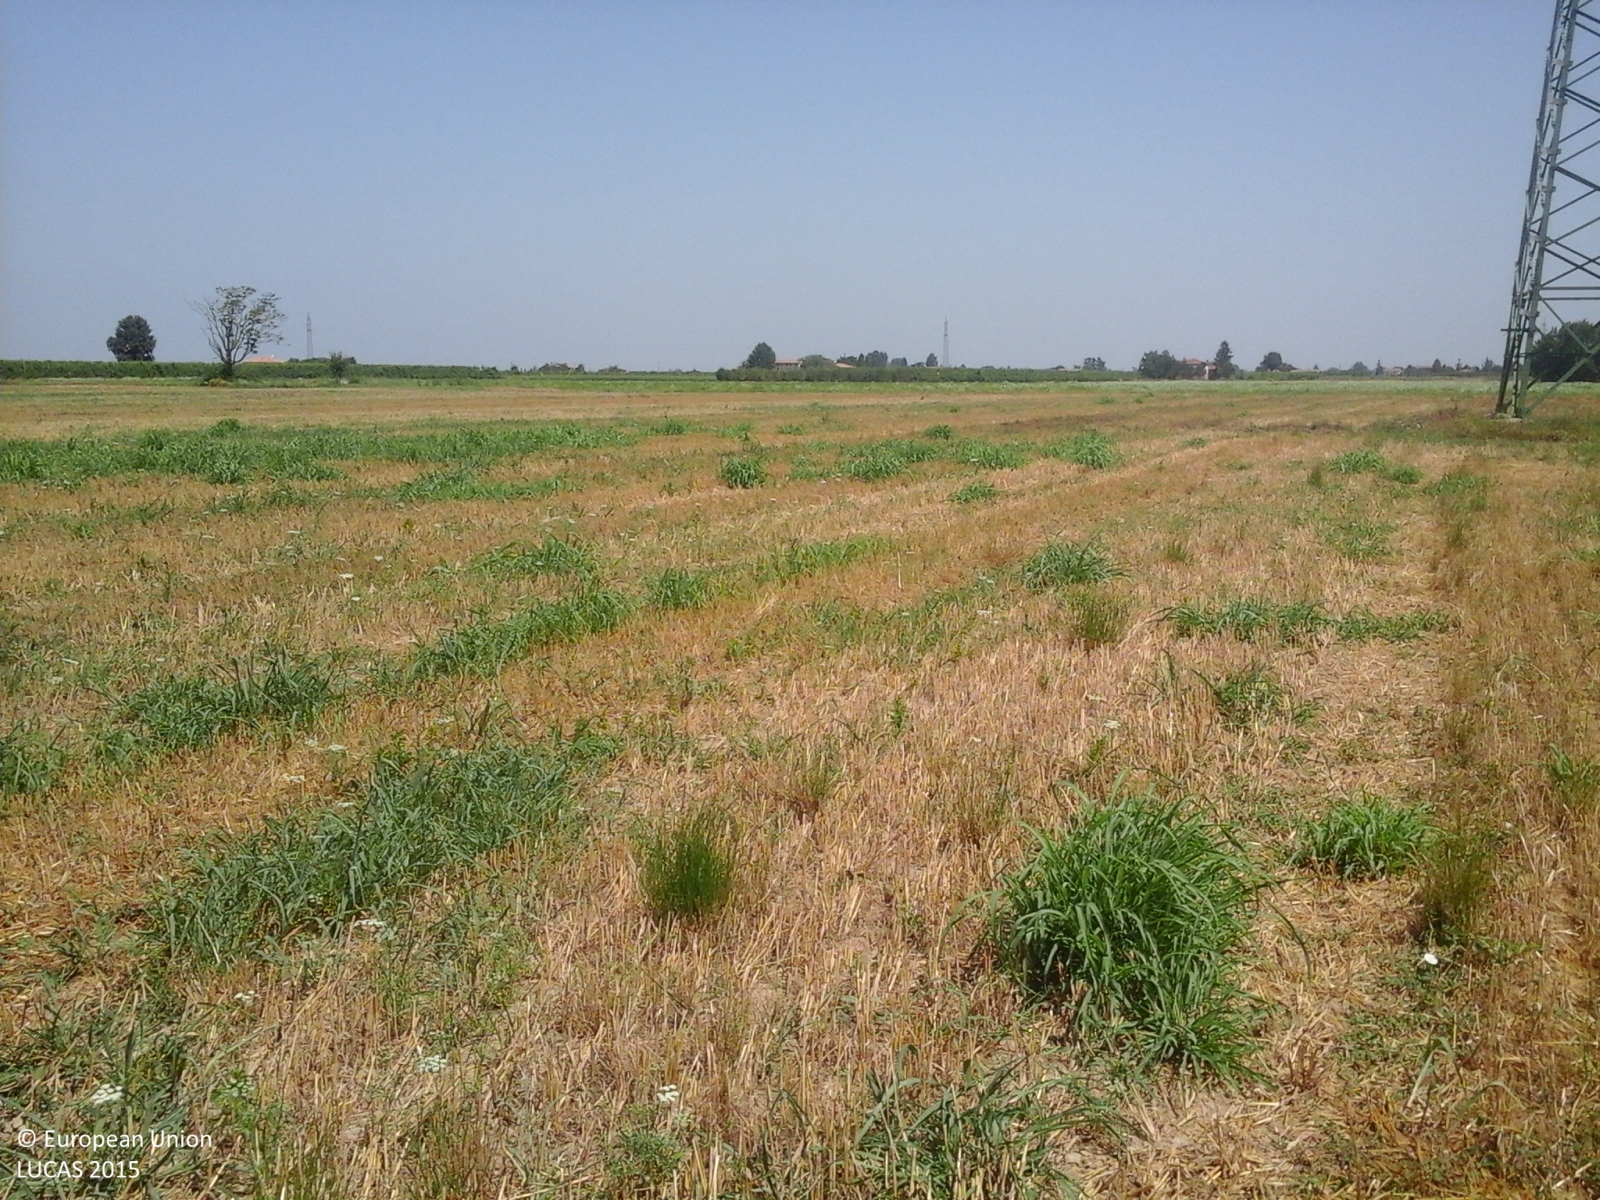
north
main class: Cropland
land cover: Common wheat
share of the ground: > 75 %
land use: Agriculture (excluding fallow land and kitchen gardens)
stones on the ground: < 10 %
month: July
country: IT
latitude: 44.4600
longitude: 11.8687
